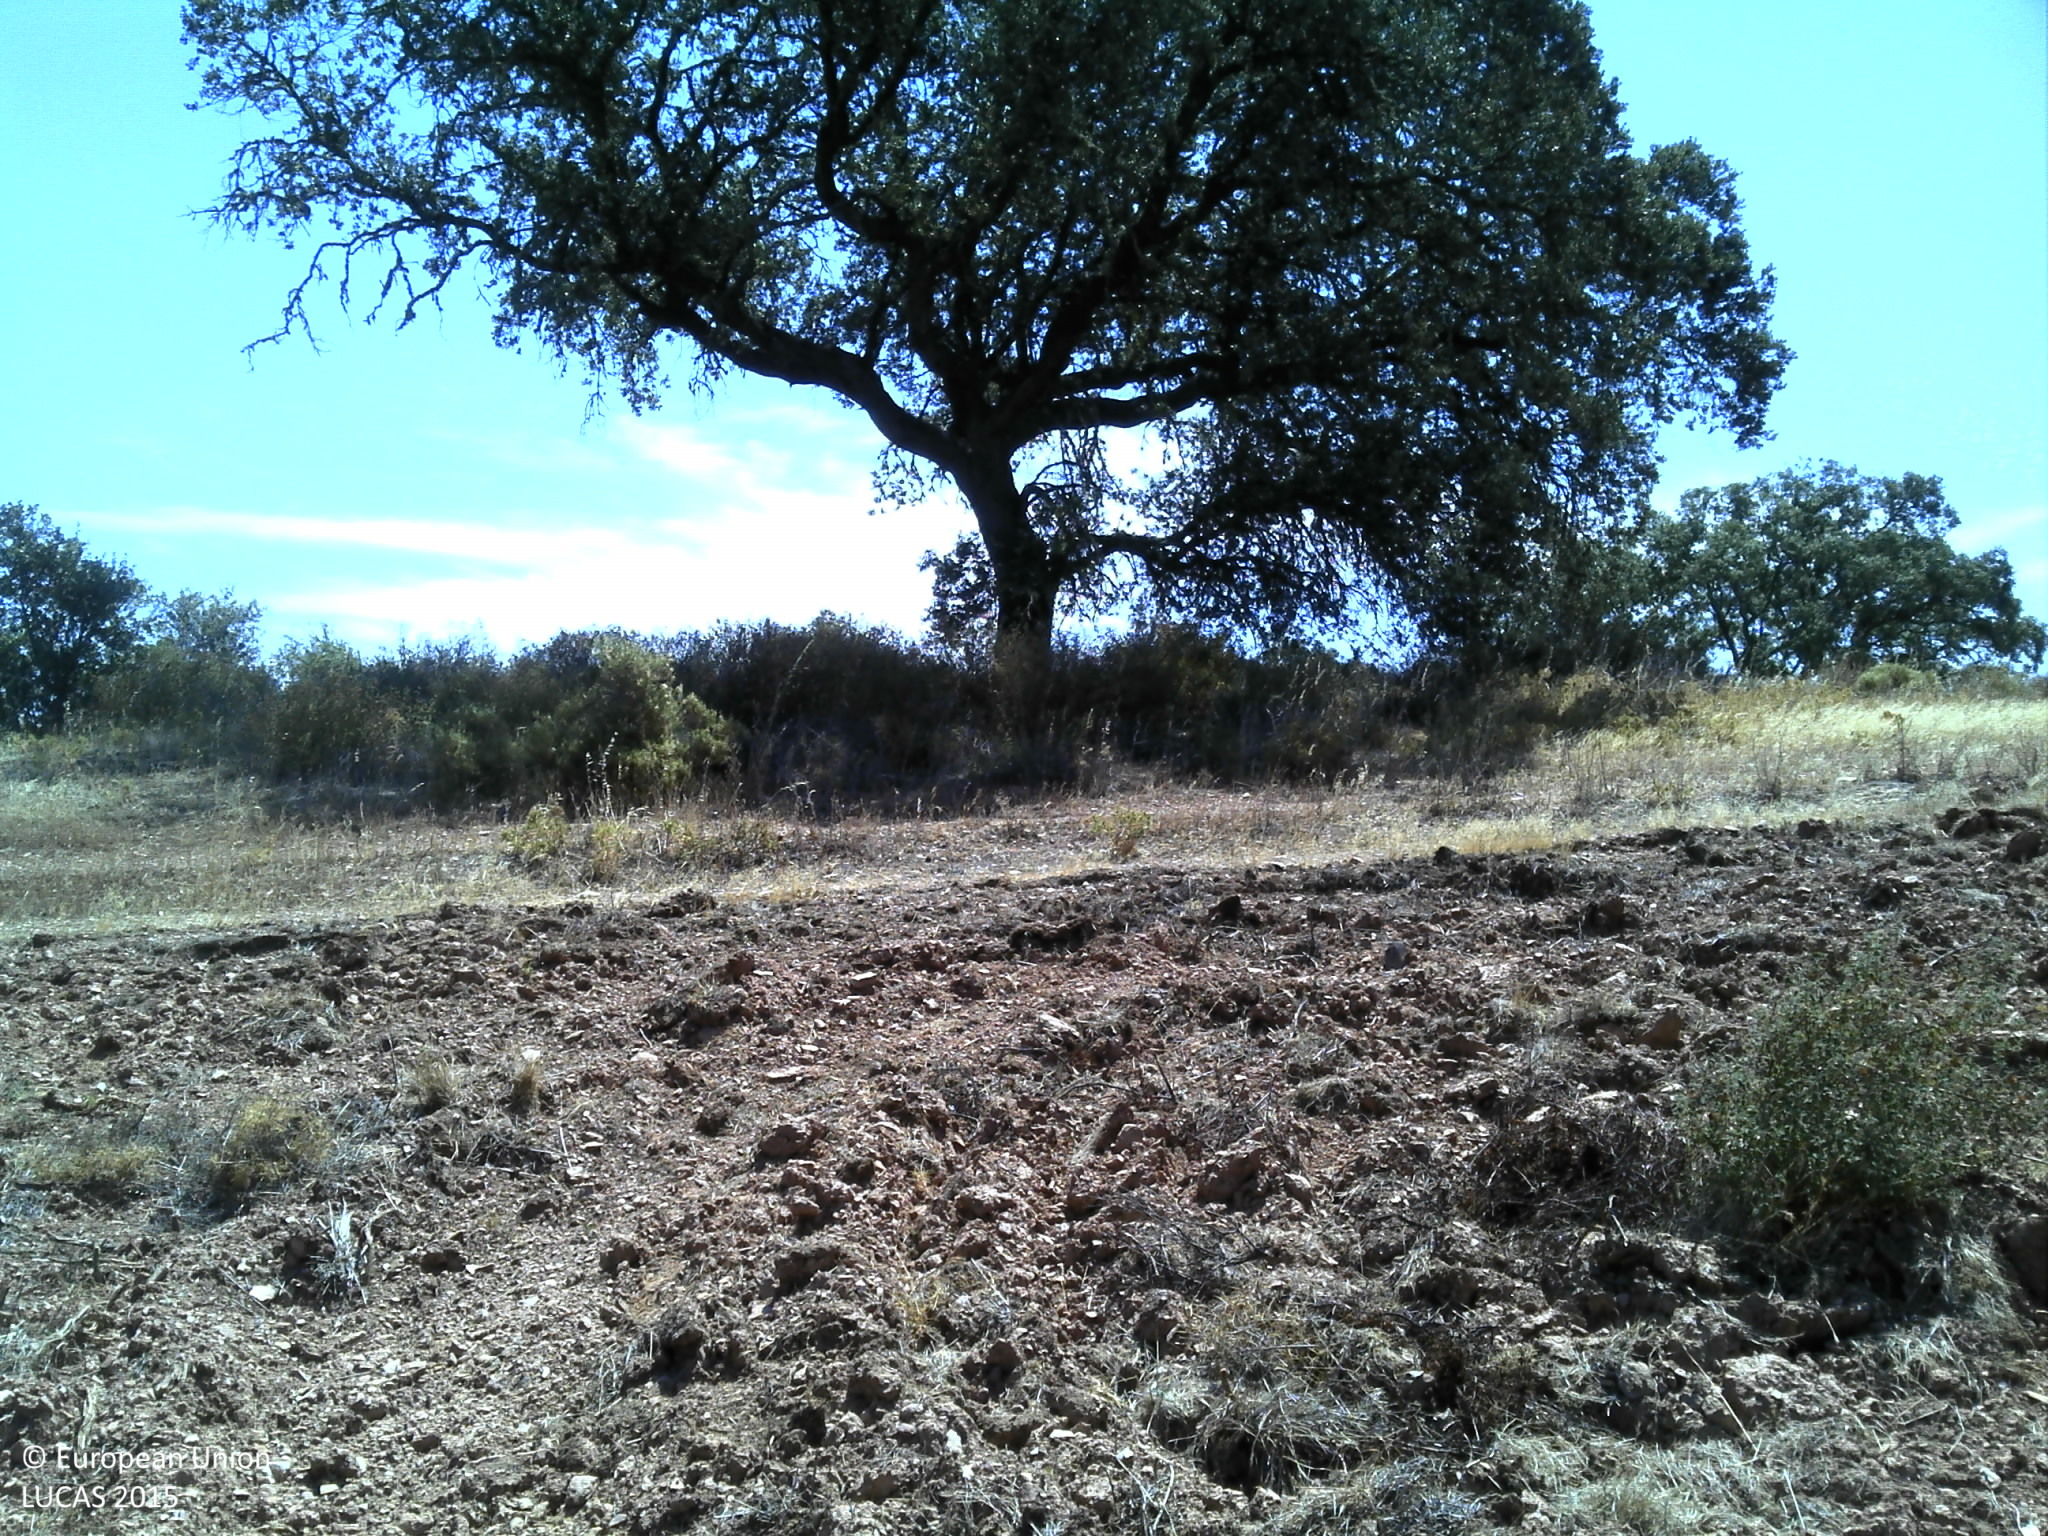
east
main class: Grassland
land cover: Grassland with sparse tree/shrub cover
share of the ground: 10 - 25 %
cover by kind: unconsolidated bare surface 75 %, herbaceous plants 20 %, broadleaved forest trees 5 %
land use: Agriculture (excluding fallow land and kitchen gardens)
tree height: < 5 m
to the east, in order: Grassland with sparse tree/shrub cover; Tracks; Broadleaved woodland; Rivers and streams; Shruby margins; Grassland without tree/shrub cover; Olive groves; Fences; Shruby margins; Other structural elements; Grassland without tree/shrub cover; Tracks; Grassland without tree/shrub cover
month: June
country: PT
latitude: 37.8481
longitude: -7.5063
